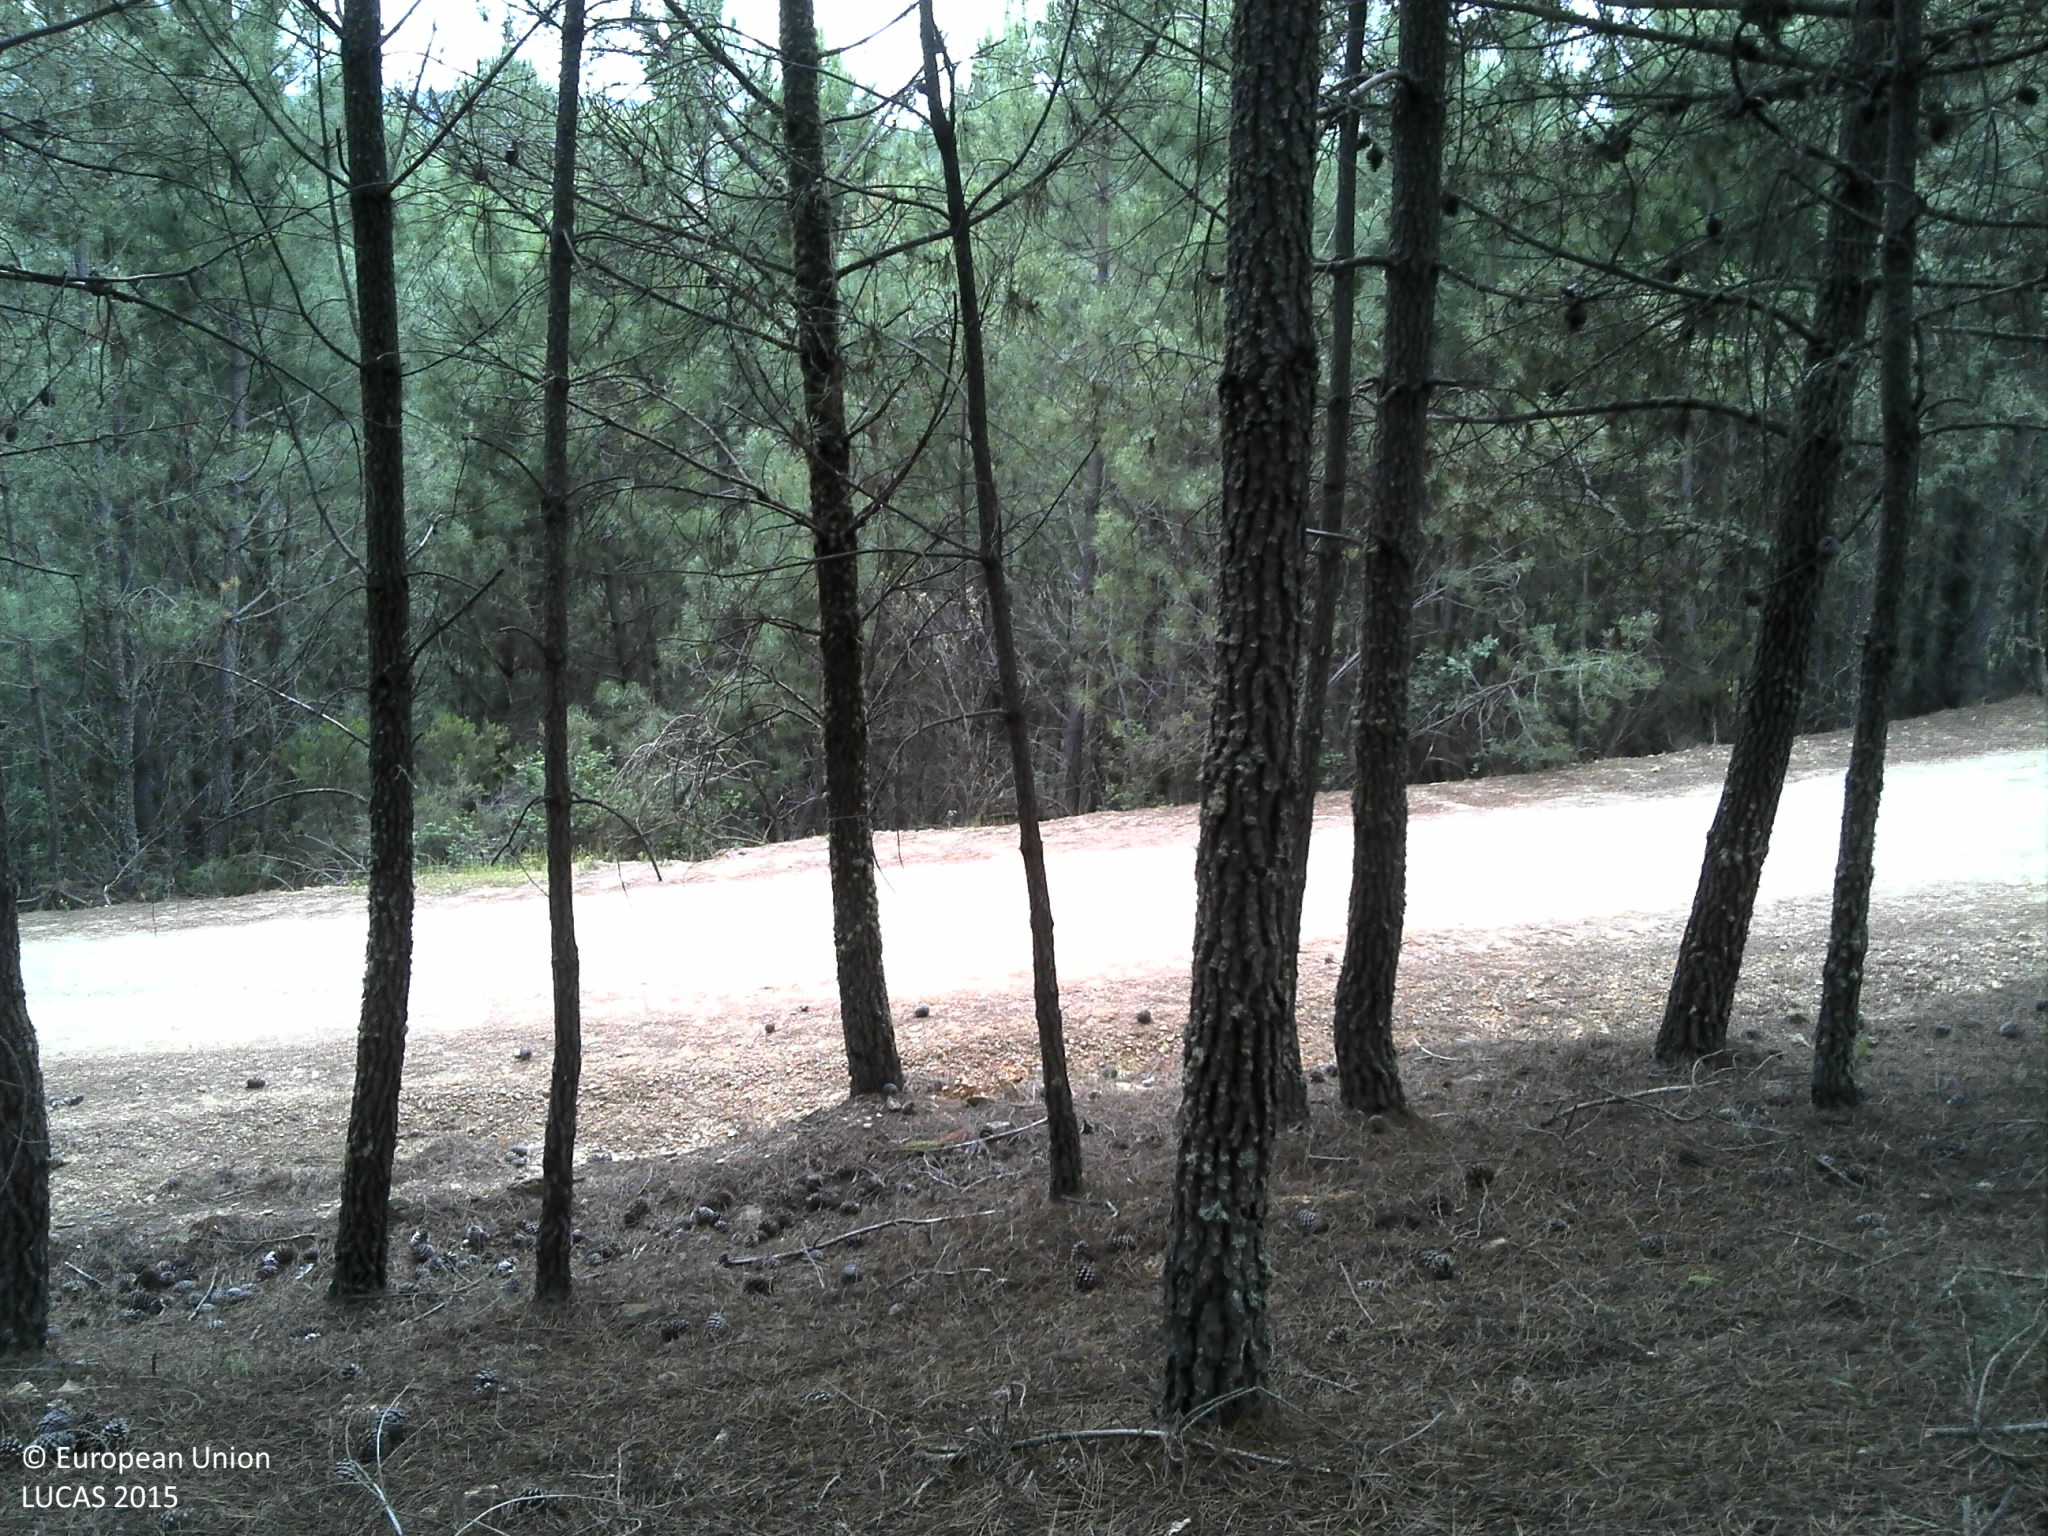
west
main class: Woodland
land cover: Pine dominated coniferous woodland
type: coniferous forest of the mediterranean region
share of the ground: 50 - 75 %
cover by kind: coniferous forest trees 75 %, unconsolidated bare surface 25 %
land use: Forestry
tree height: > 5 m
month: May
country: PT
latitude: 41.7596
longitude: -7.0917
